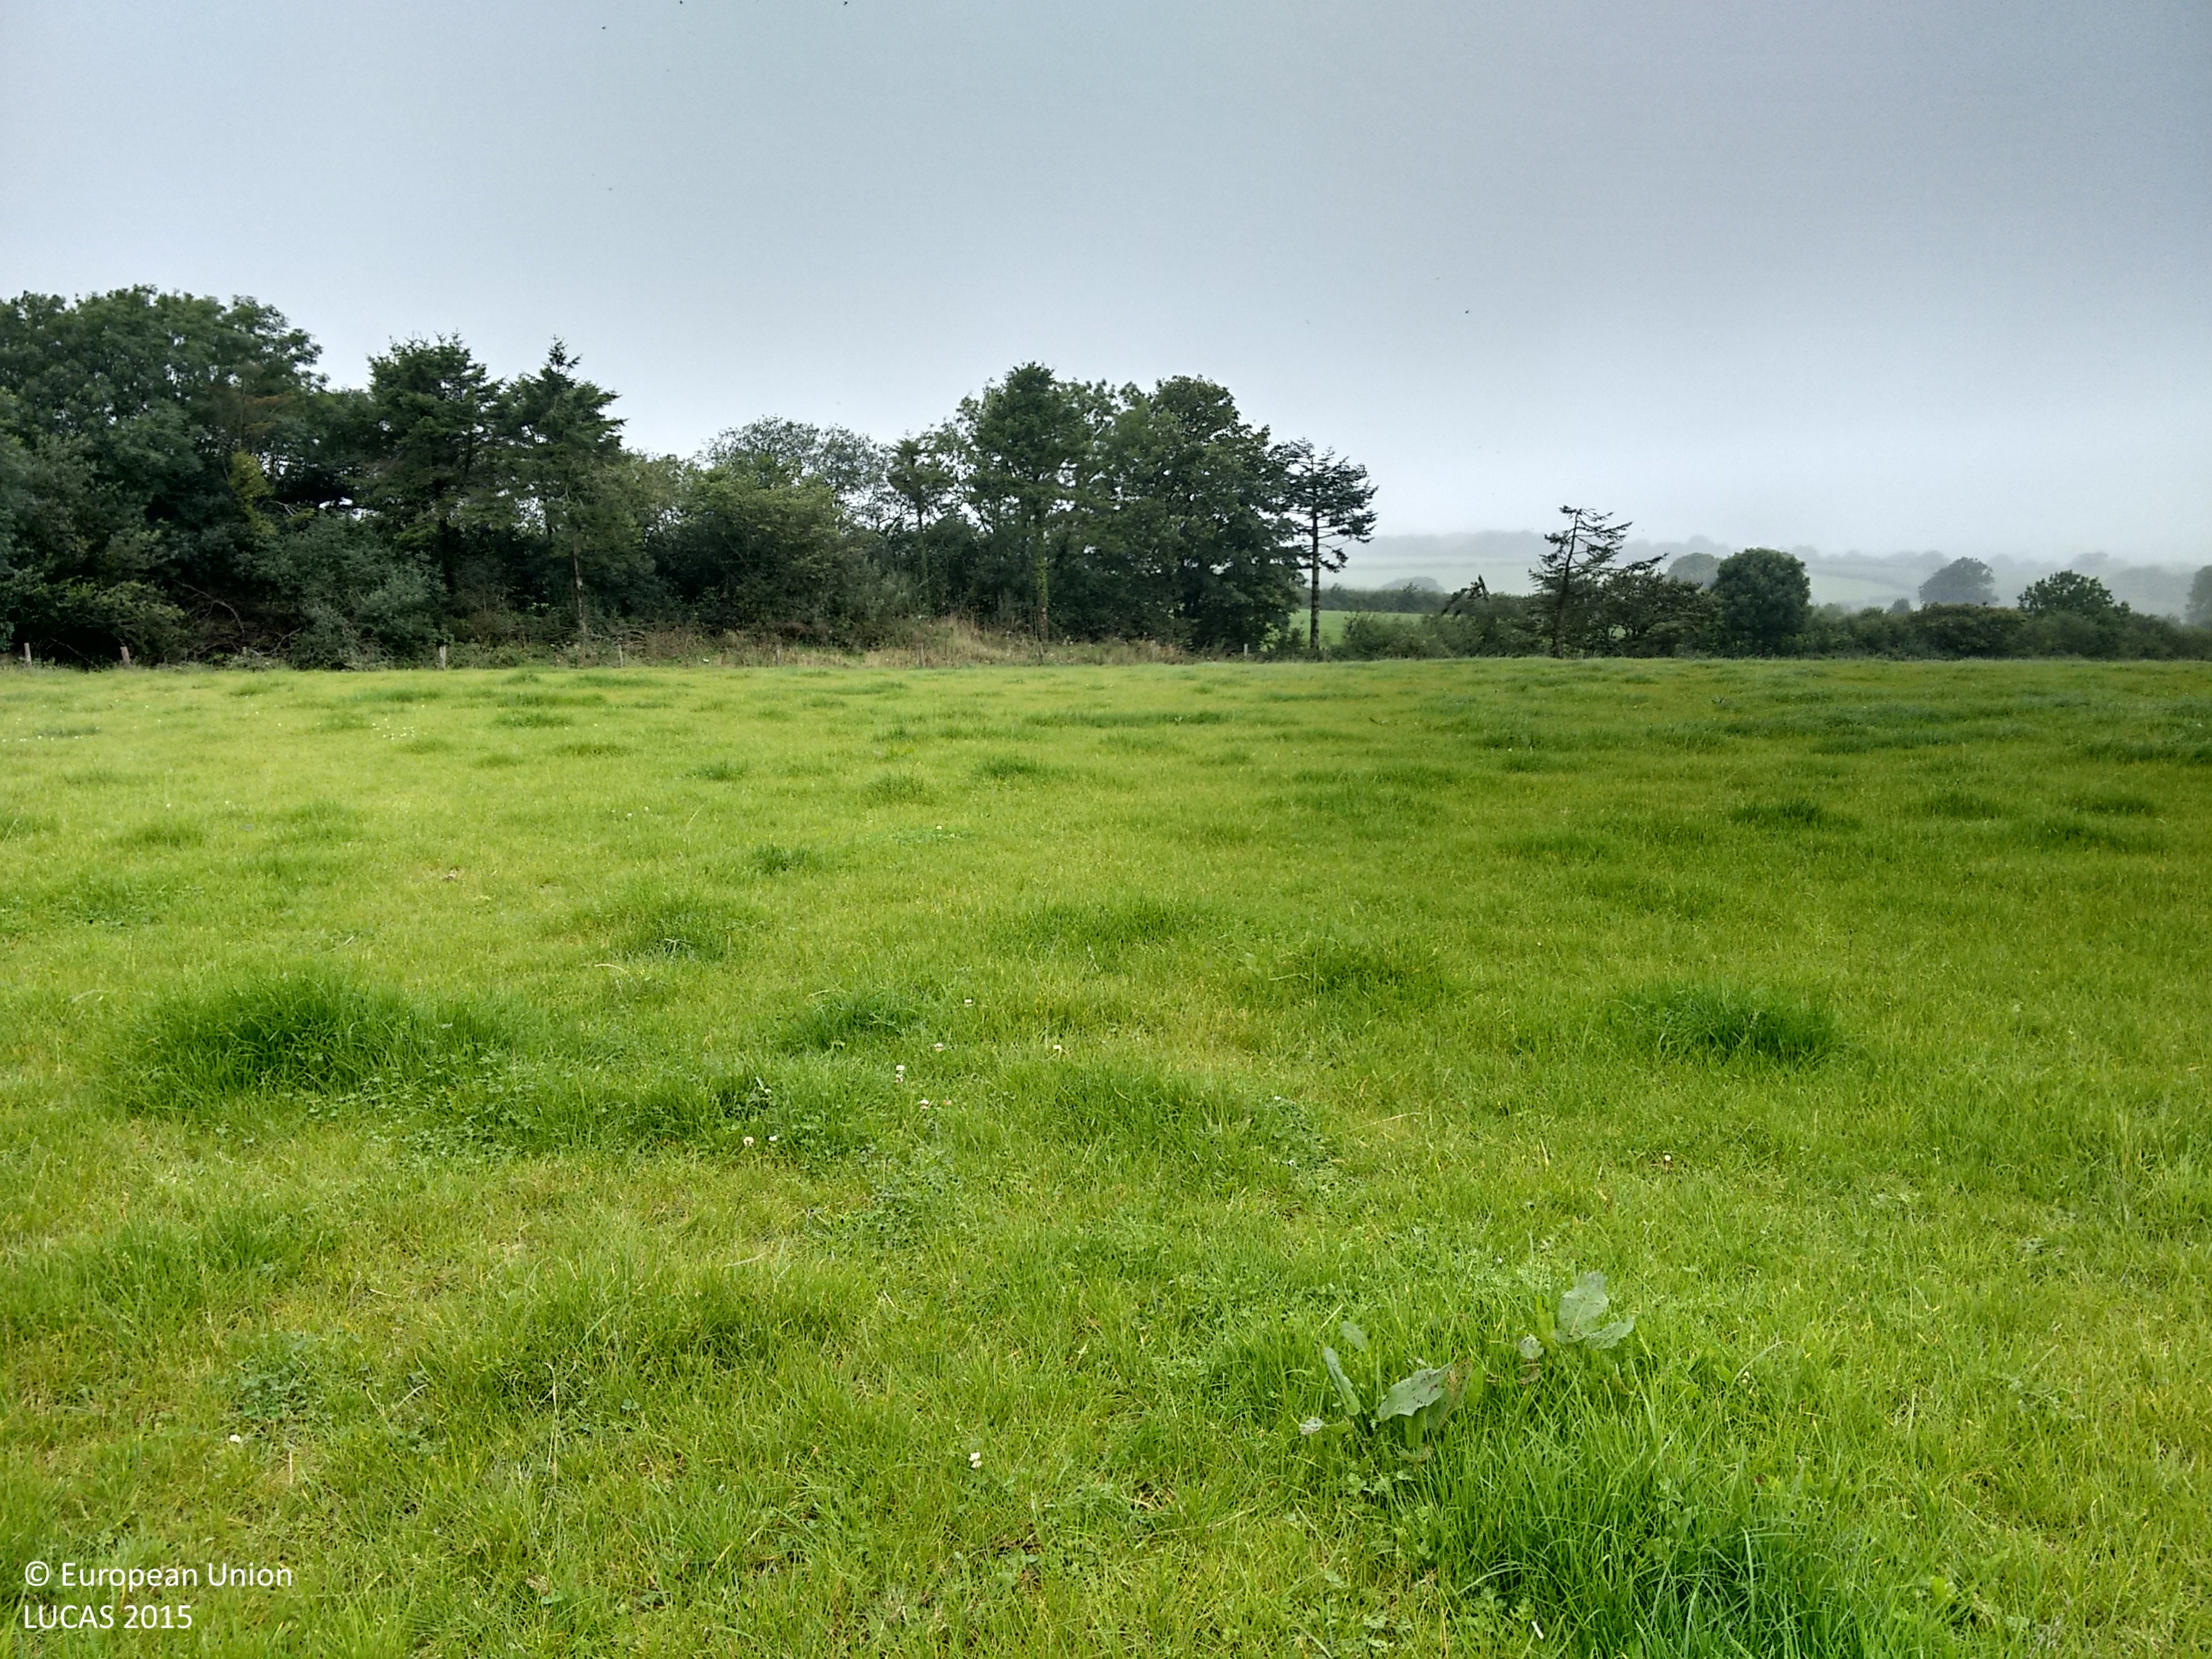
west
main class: Grassland
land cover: Grassland without tree/shrub cover
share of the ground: > 75 %
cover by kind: herbaceous plants 100 %
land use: Agriculture (excluding fallow land and kitchen gardens)
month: August
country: GB
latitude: 51.7908
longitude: -4.6506
